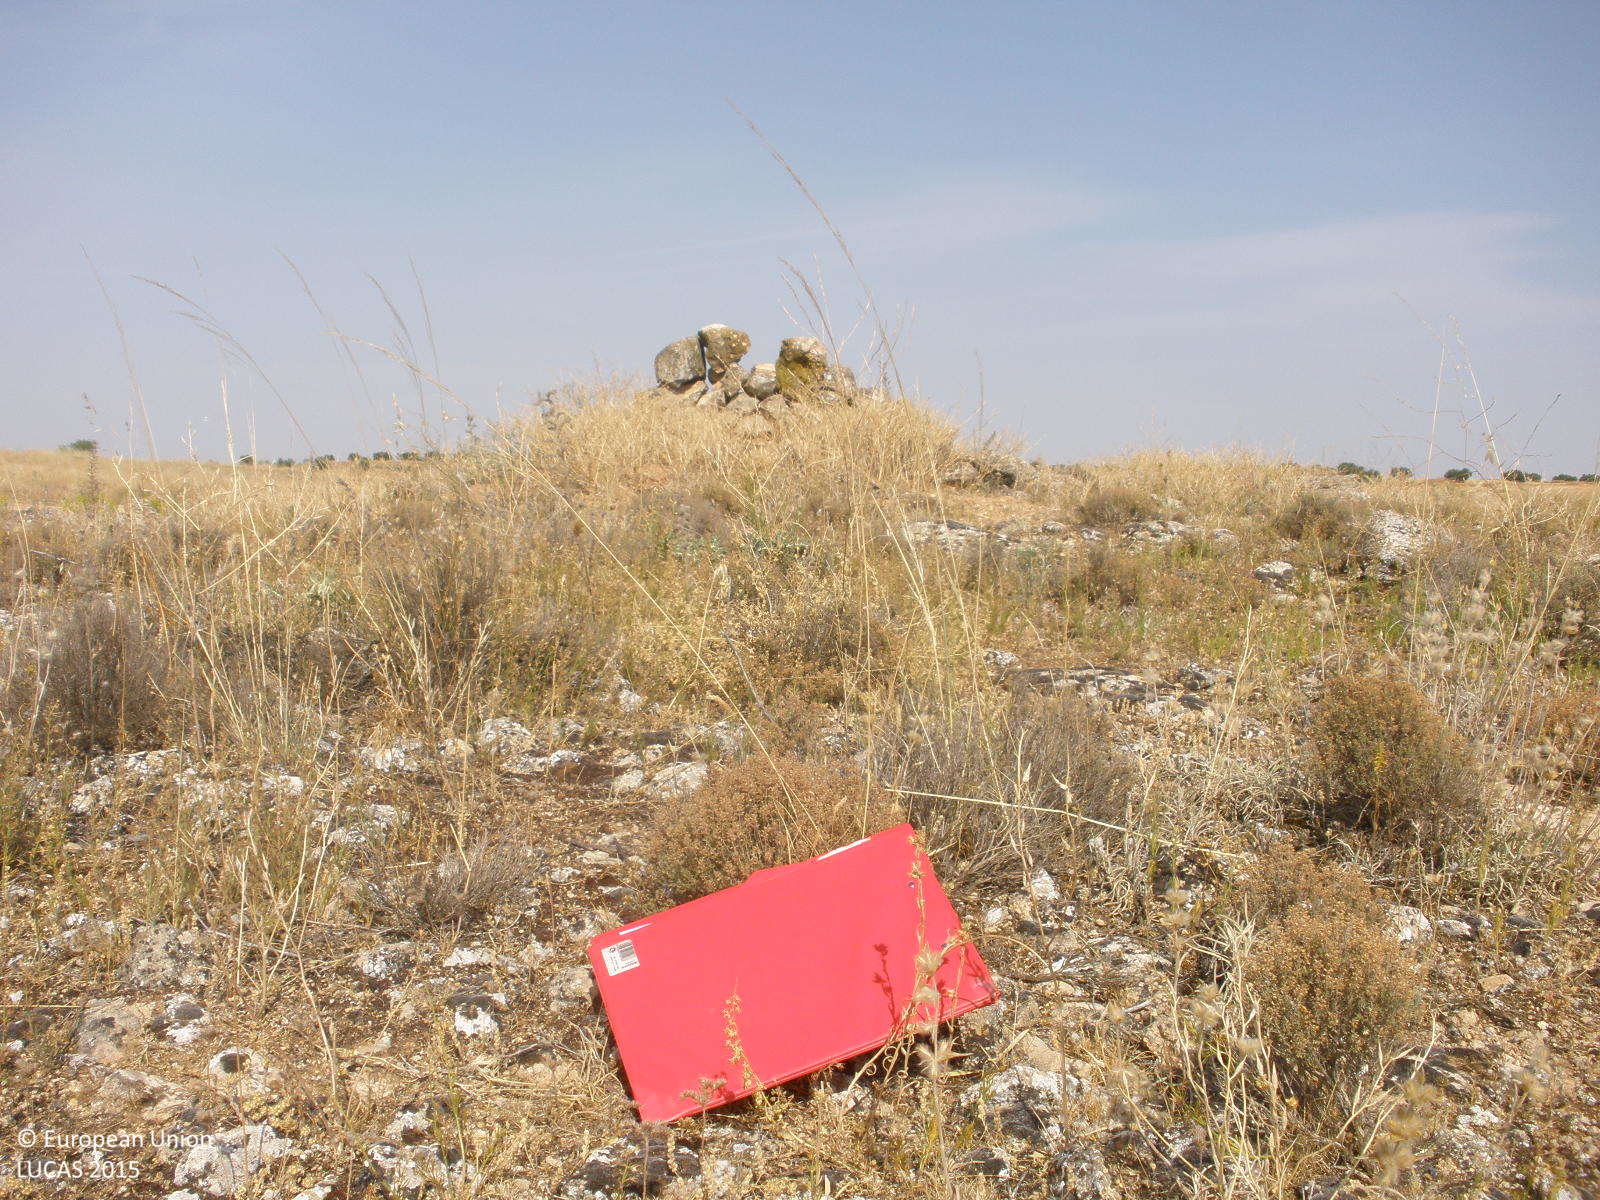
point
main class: Shrubland
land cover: Shrubland without tree cover
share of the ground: 25 - 50 %
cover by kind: shrubs 40 %, herbaceous plants 40 %, consolidated bare surface 20 %
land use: Semi-natural and natural areas not in use
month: July
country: ES
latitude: 39.7691
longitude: -3.3682
